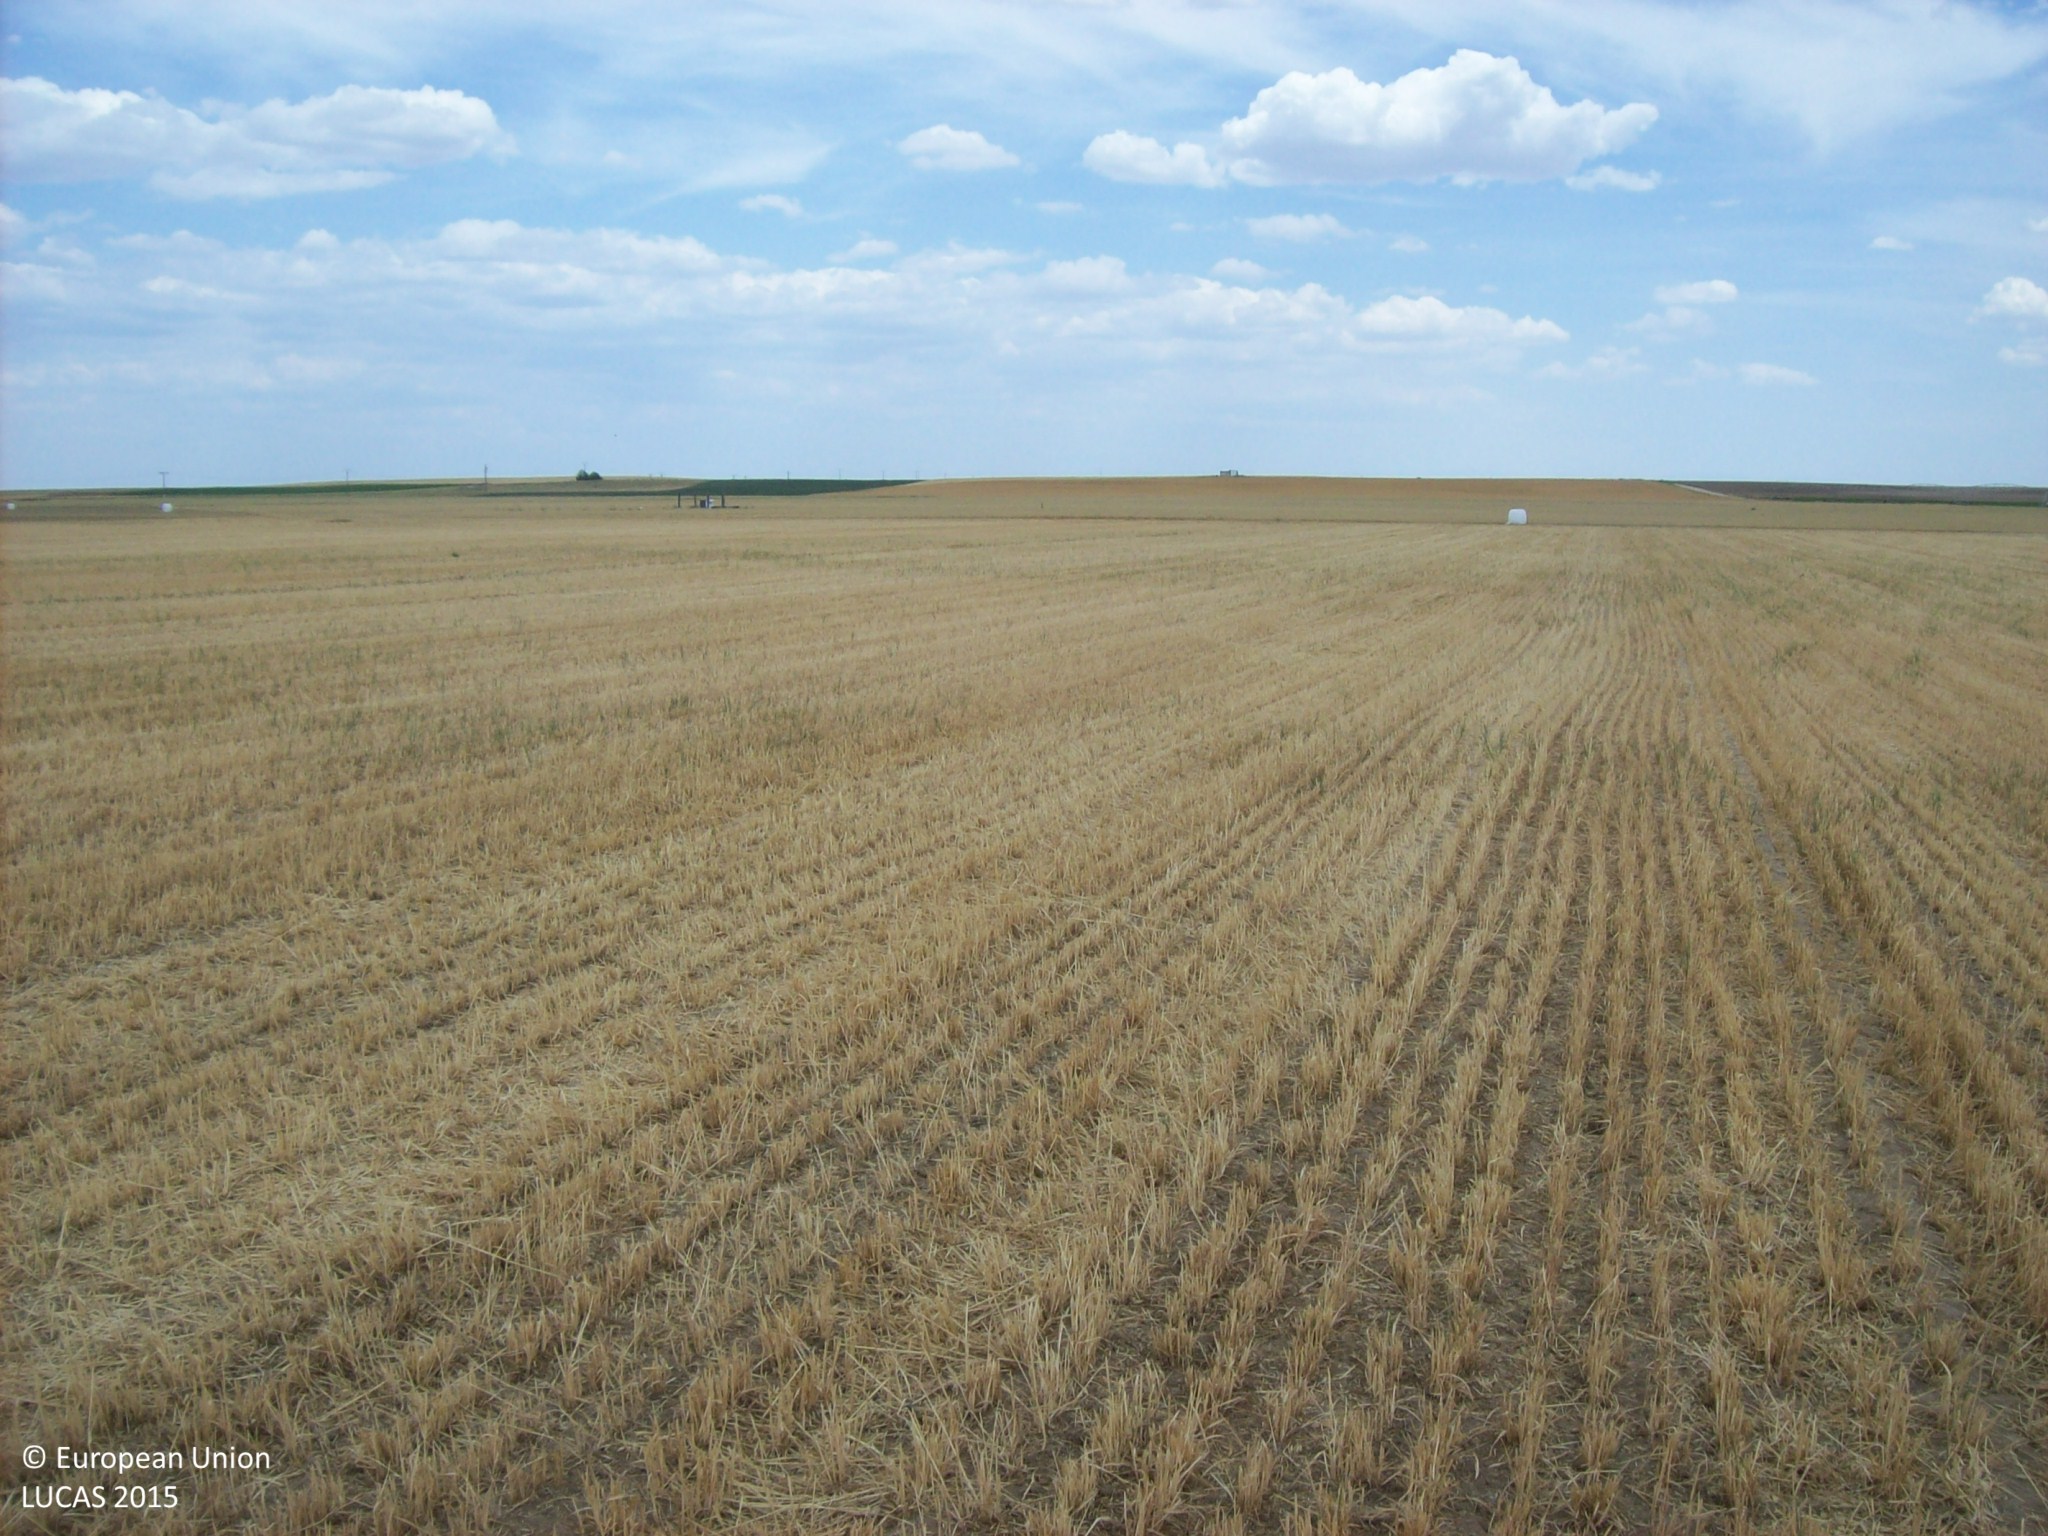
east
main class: Cropland
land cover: Mixed cereals for fodder
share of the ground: < 10 %
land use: Agriculture (excluding fallow land and kitchen gardens)
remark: Harvested field
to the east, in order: Mixed cereals for fodder; Grass margins; Common wheat; Grass margins; Tracks; Grass margins; Common wheat; Grass margins; Tracks; Grass margins; Common wheat
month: June
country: ES
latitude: 41.1981
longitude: -5.0093
